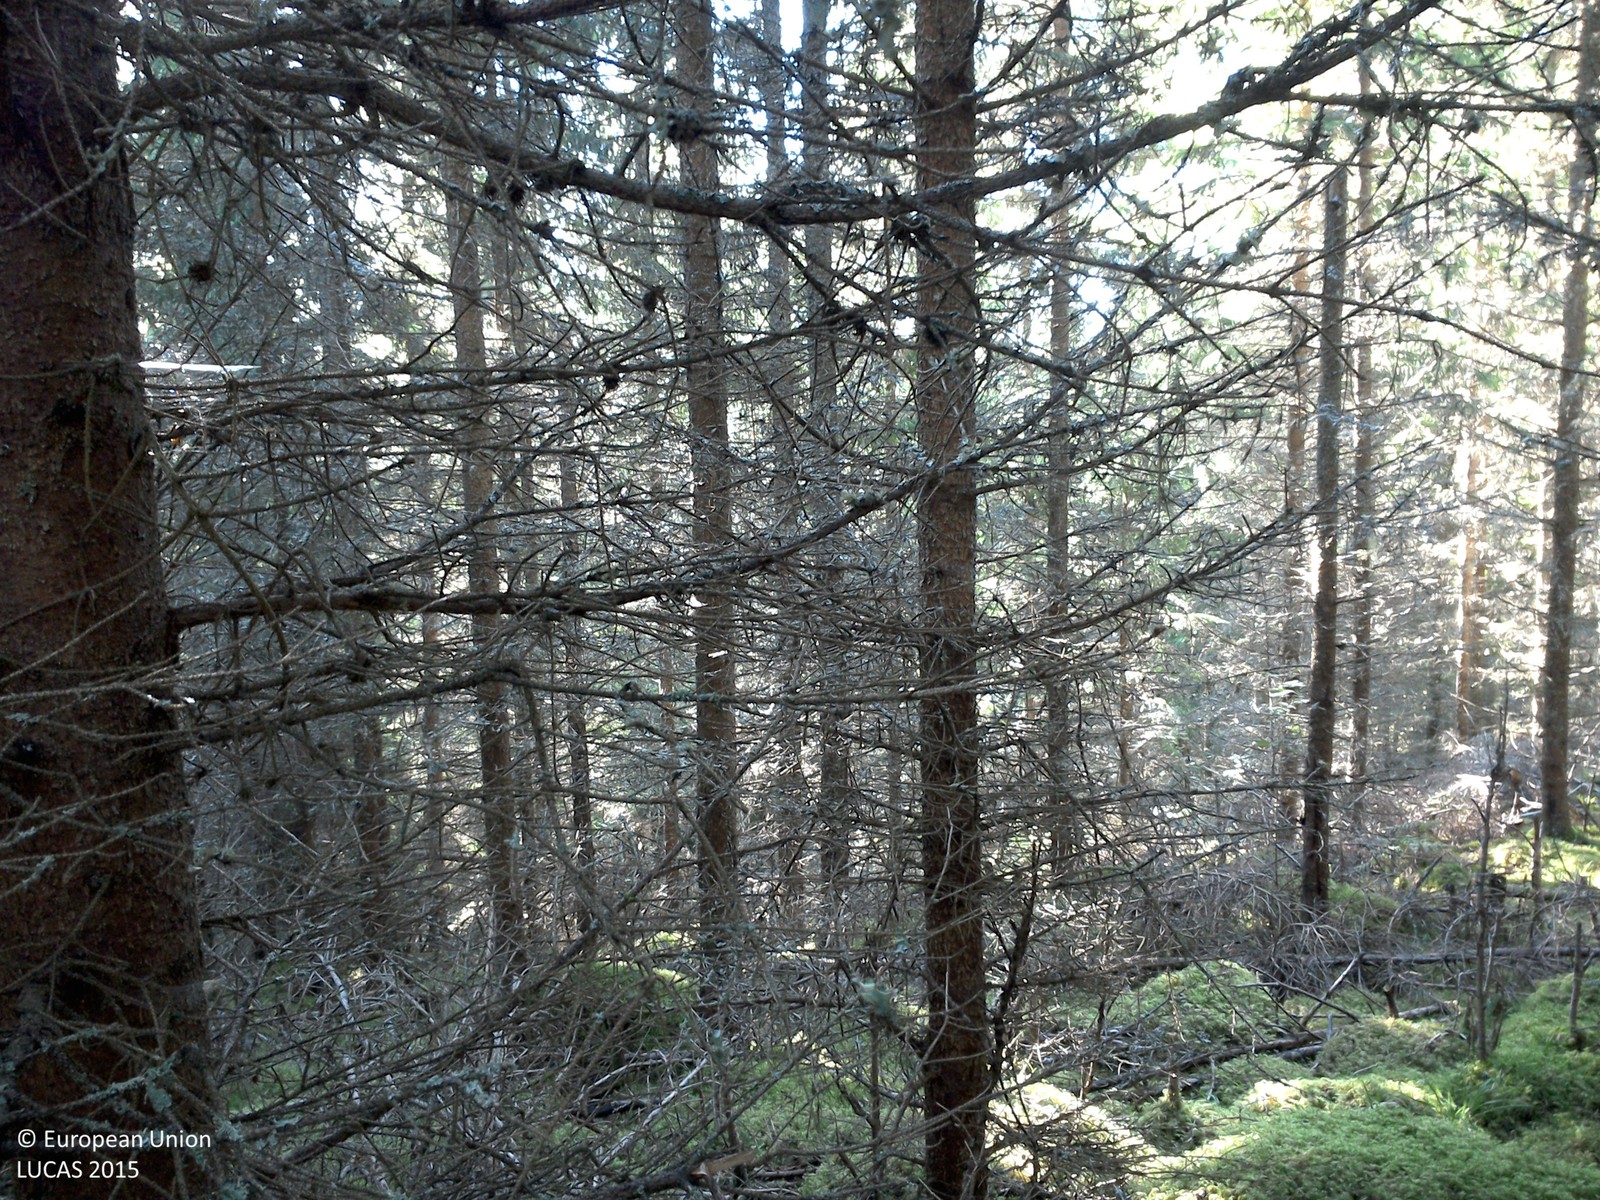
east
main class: Woodland
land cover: Spruce dominated coniferous woodland
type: boreal forest
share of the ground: > 75 %
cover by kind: coniferous forest trees 80 %, lichens and mosses 20 %
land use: Forestry
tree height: > 5 m
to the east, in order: Spruce dominated coniferous woodland; Broadleaved woodland; Spruce dominated mixed woodland; Spruce dominated coniferous woodland; Inland marshes; Electric lines; Inland marshes; Spruce dominated coniferous woodland; Ditches and canals; Spruce dominated coniferous woodland; Ditches and canals; Spruce dominated coniferous woodland; Ditches and canals; Spruce dominated coniferous woodland; Grassland without tree/shrub cover
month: August
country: SE
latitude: 58.1289
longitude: 14.9359
